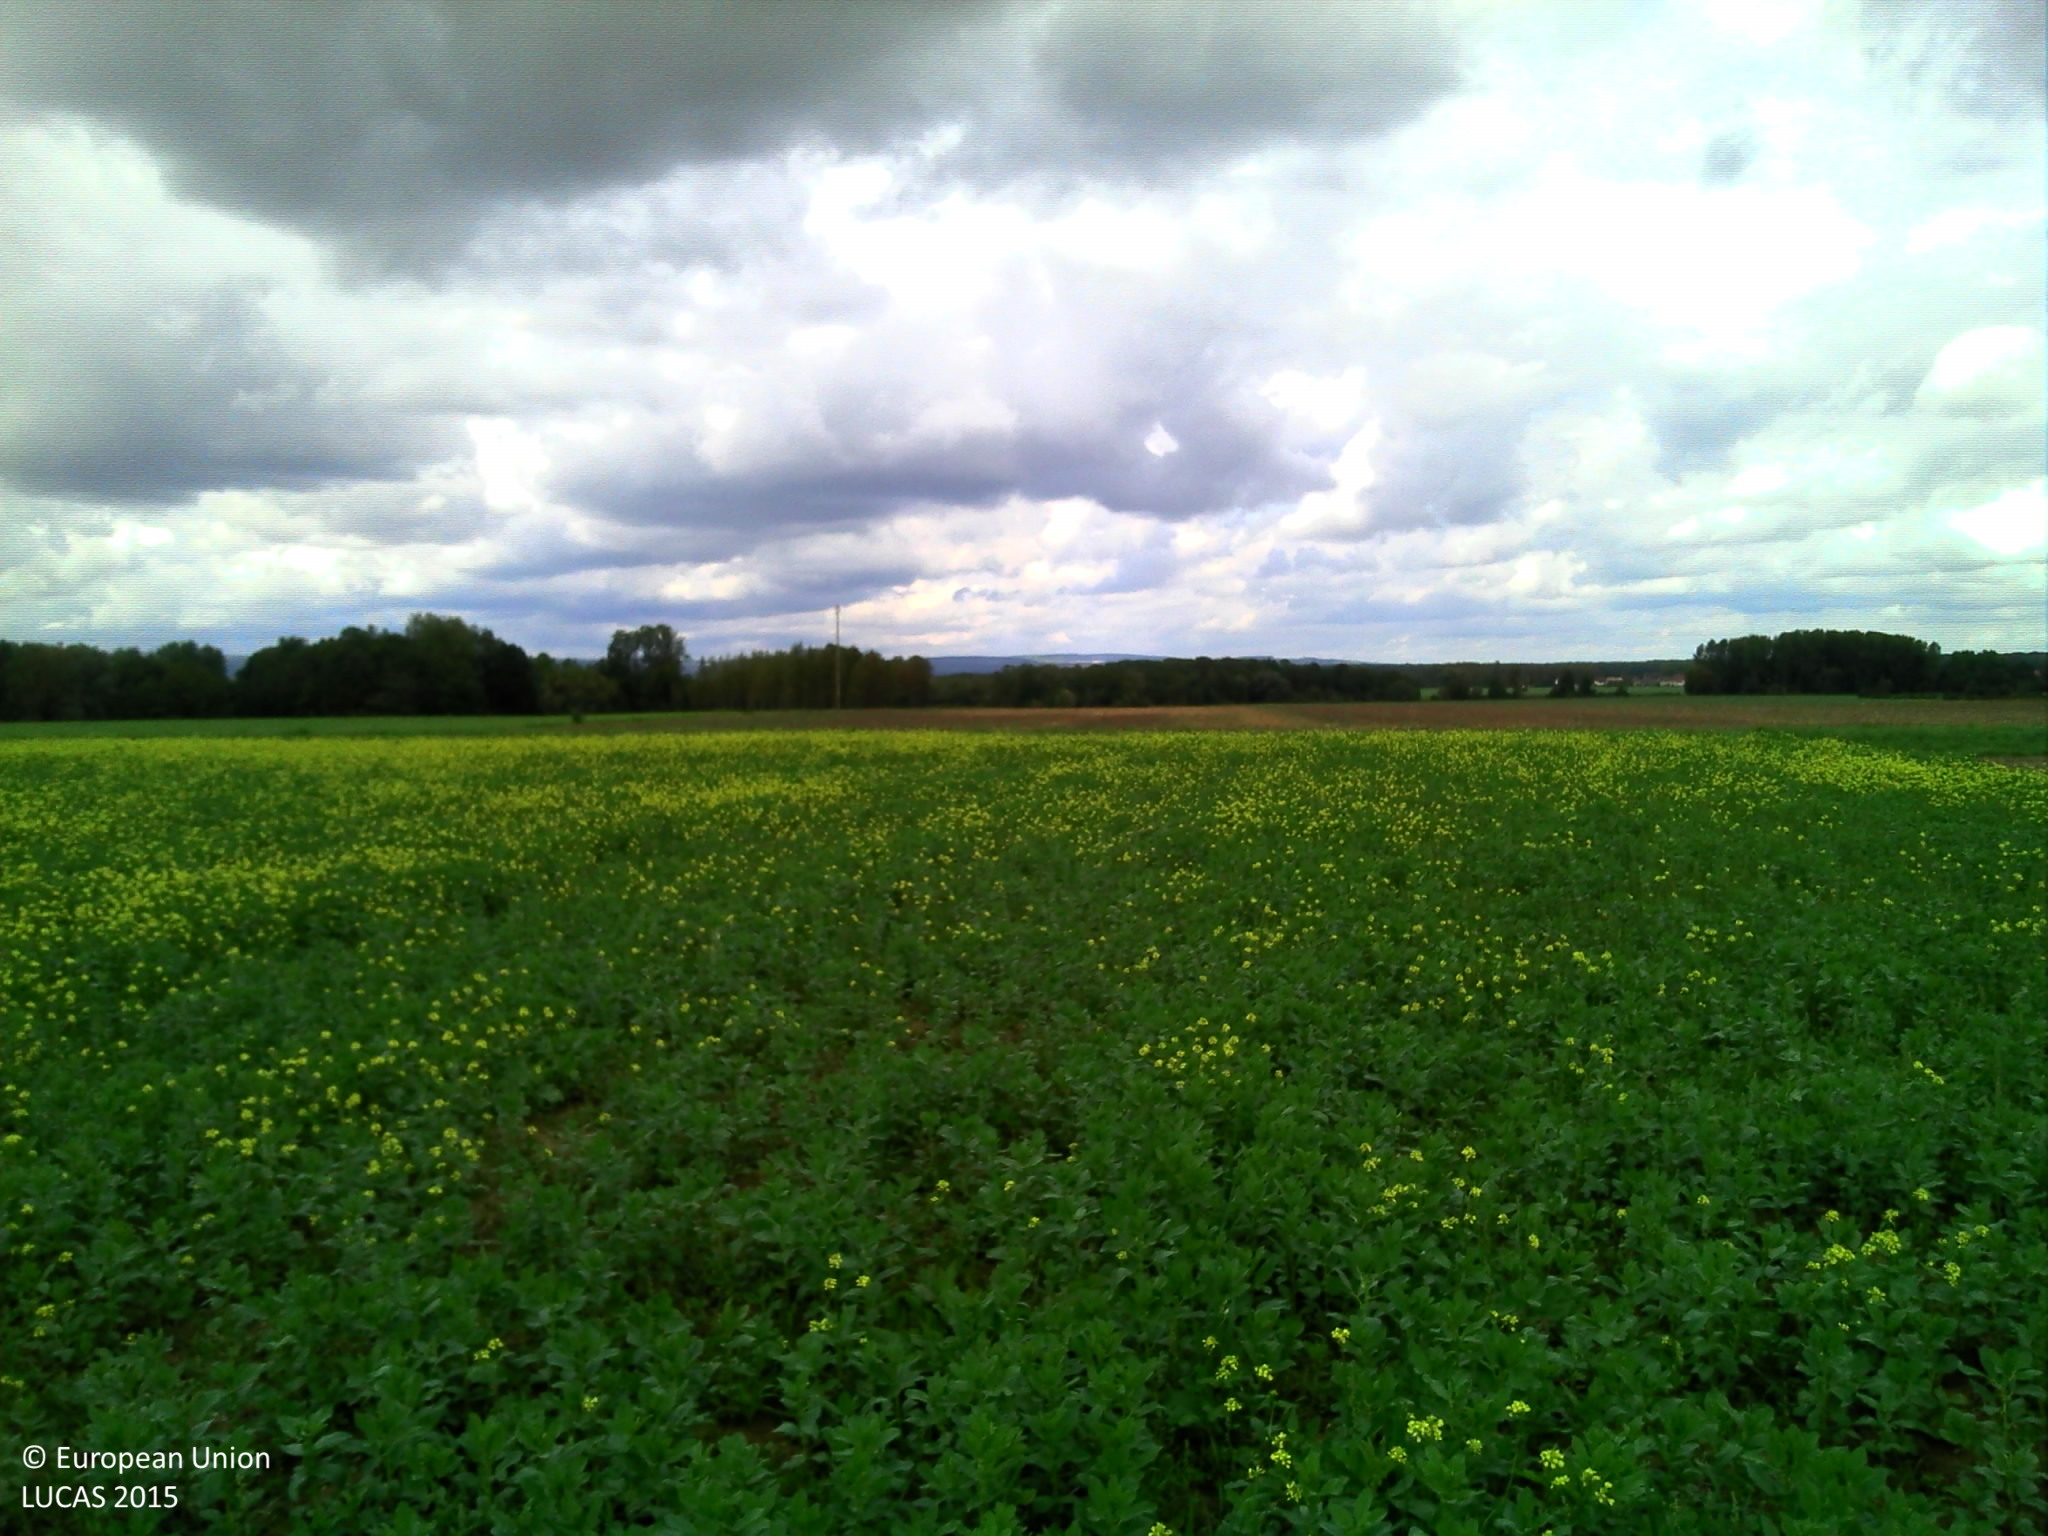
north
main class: Cropland
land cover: Other fibre and oleaginous crops
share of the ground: > 75 %
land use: Agriculture (excluding fallow land and kitchen gardens)
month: September
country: FR
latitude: 46.9880
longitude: 4.9126
